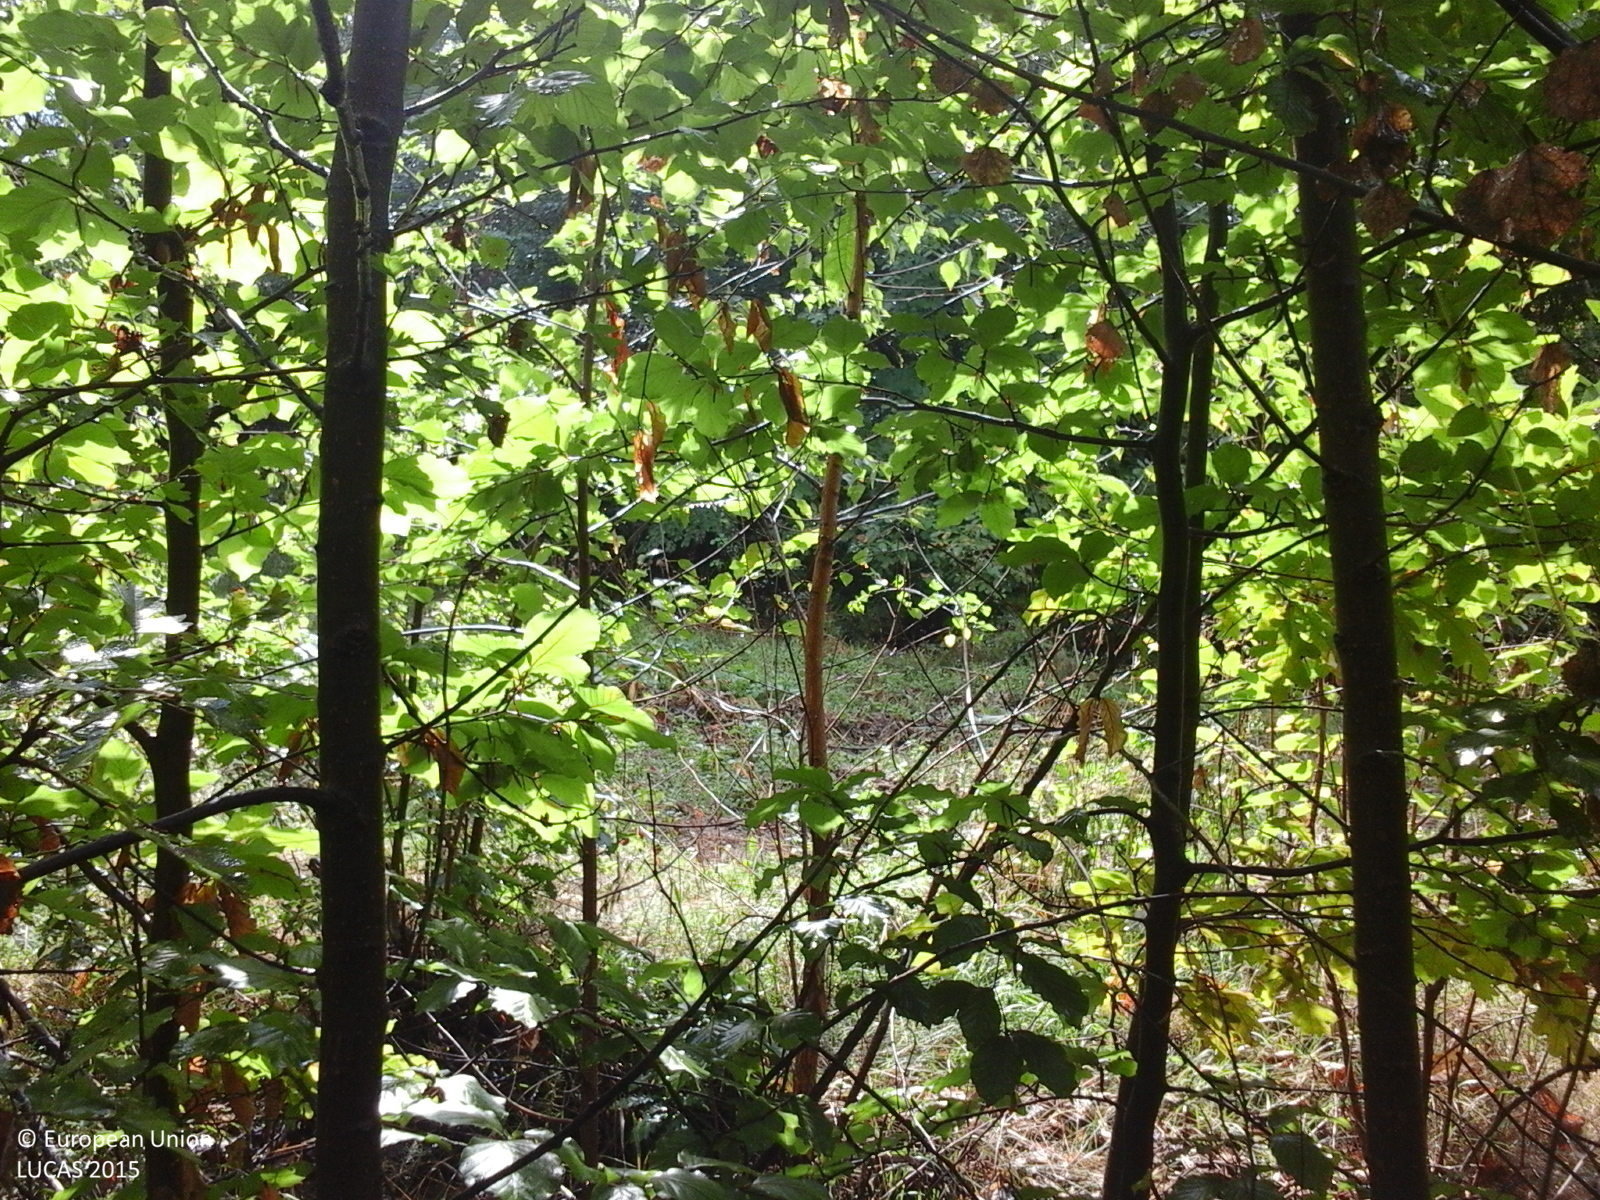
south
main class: Woodland
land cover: Broadleaved woodland
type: acidophilous oak and oak-birch forest
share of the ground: > 75 %
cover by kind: broadleaved forest trees 100 %
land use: Forestry
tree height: > 5 m
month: September
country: RO
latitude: 45.2241
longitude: 24.5328
